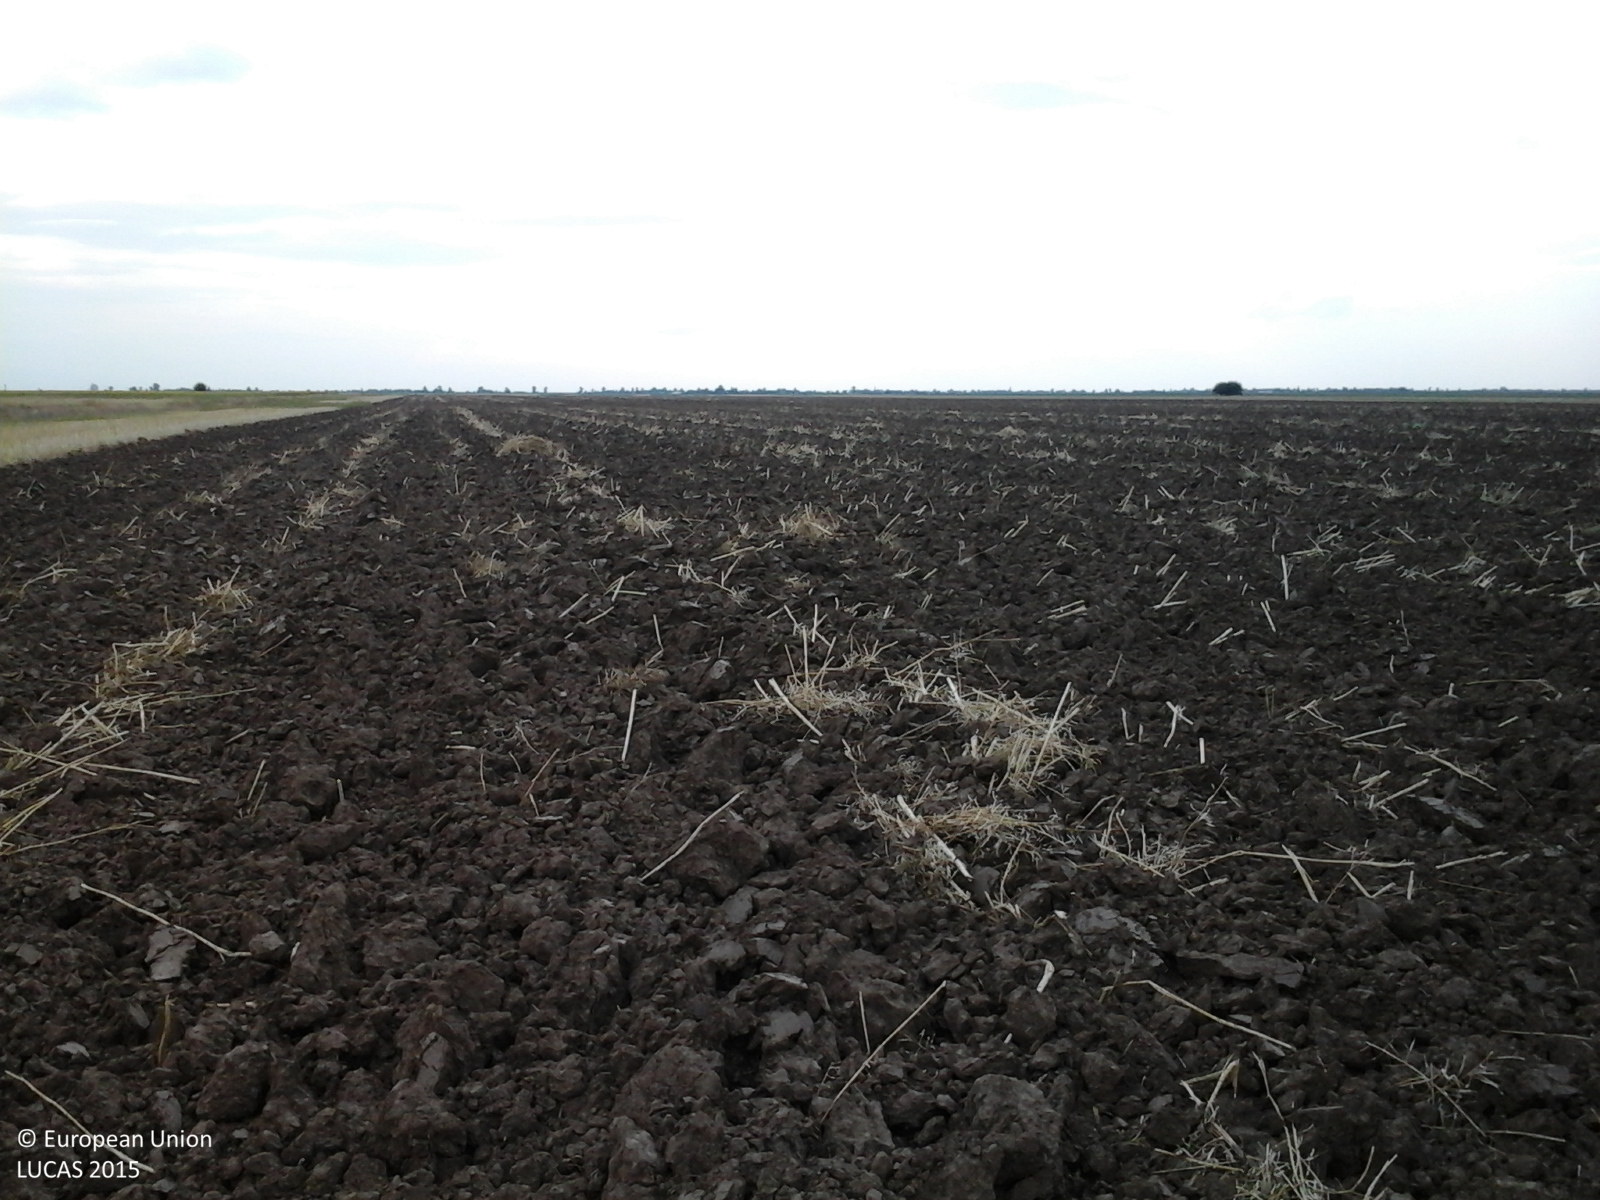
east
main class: Cropland
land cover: Rape and turnip rape
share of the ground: < 10 %
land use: Agriculture (excluding fallow land and kitchen gardens)
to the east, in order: Rape and turnip rape
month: July
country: RO
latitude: 44.2136
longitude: 25.3168
